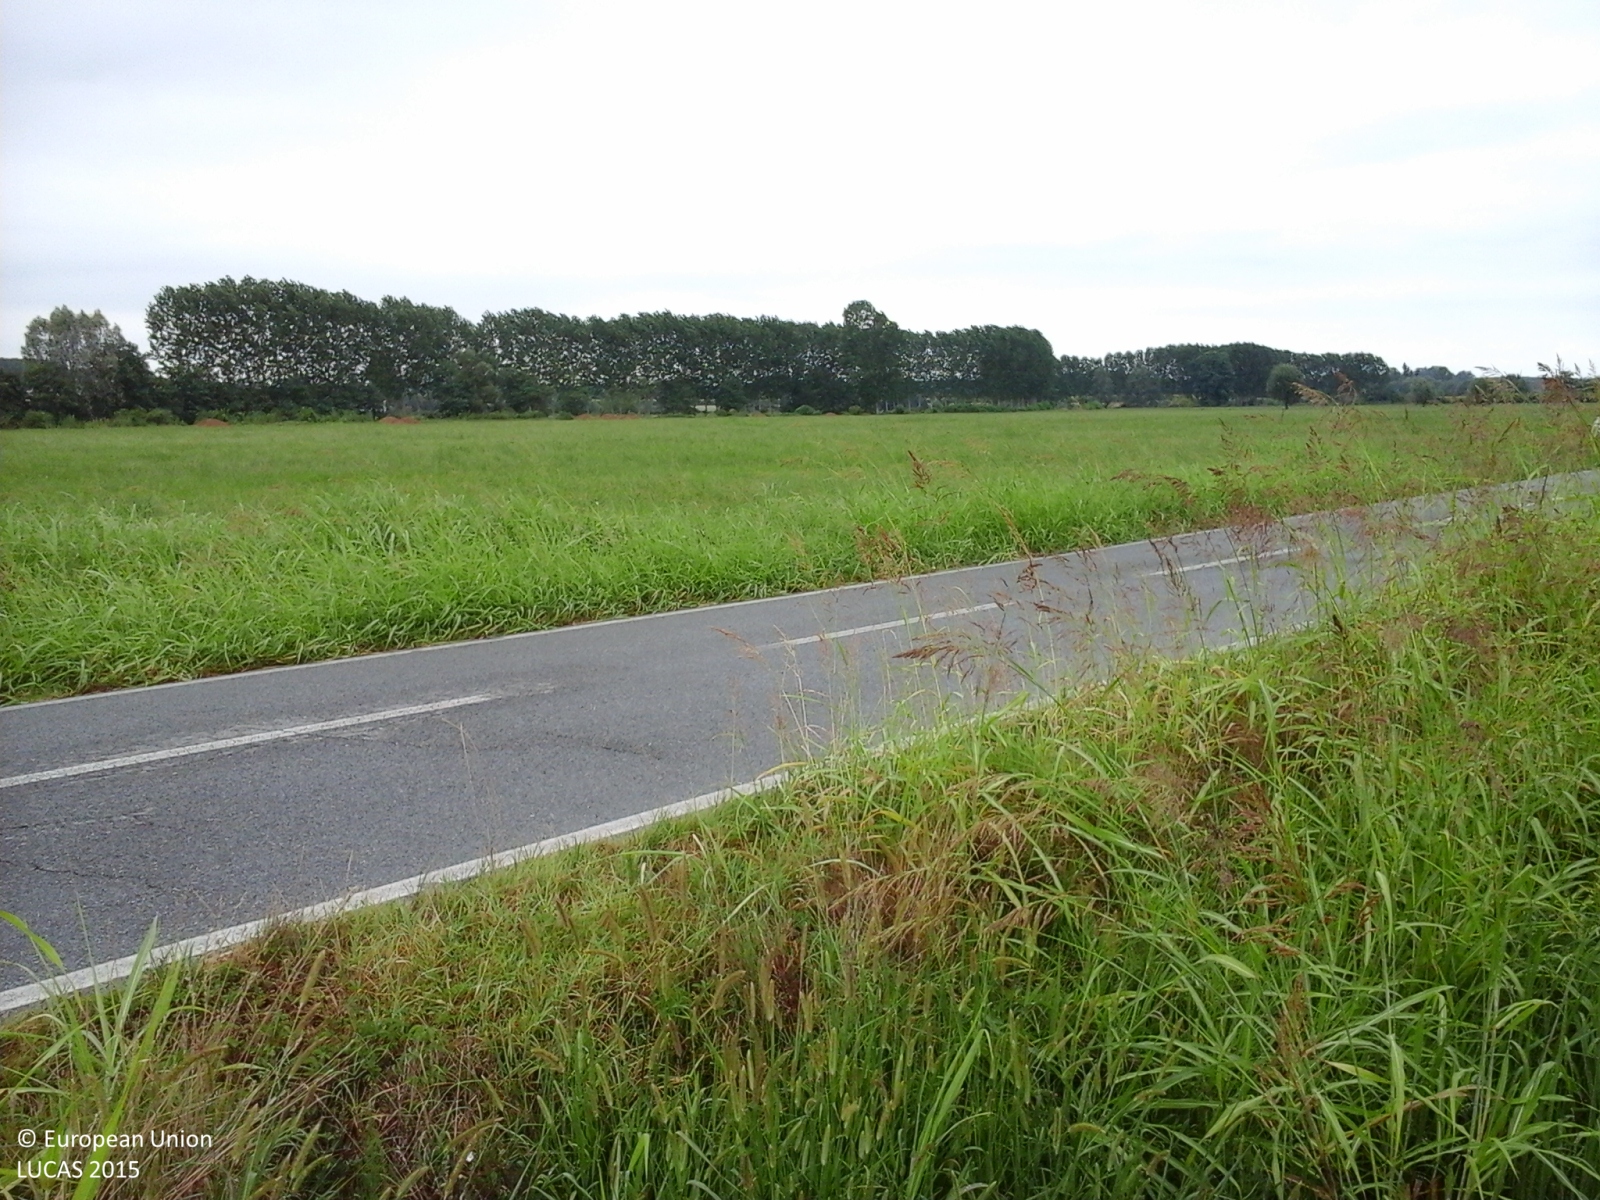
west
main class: Cropland
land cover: Soya
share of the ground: > 75 %
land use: Agriculture (excluding fallow land and kitchen gardens)
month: July
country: IT
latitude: 44.7950
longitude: 7.7416
